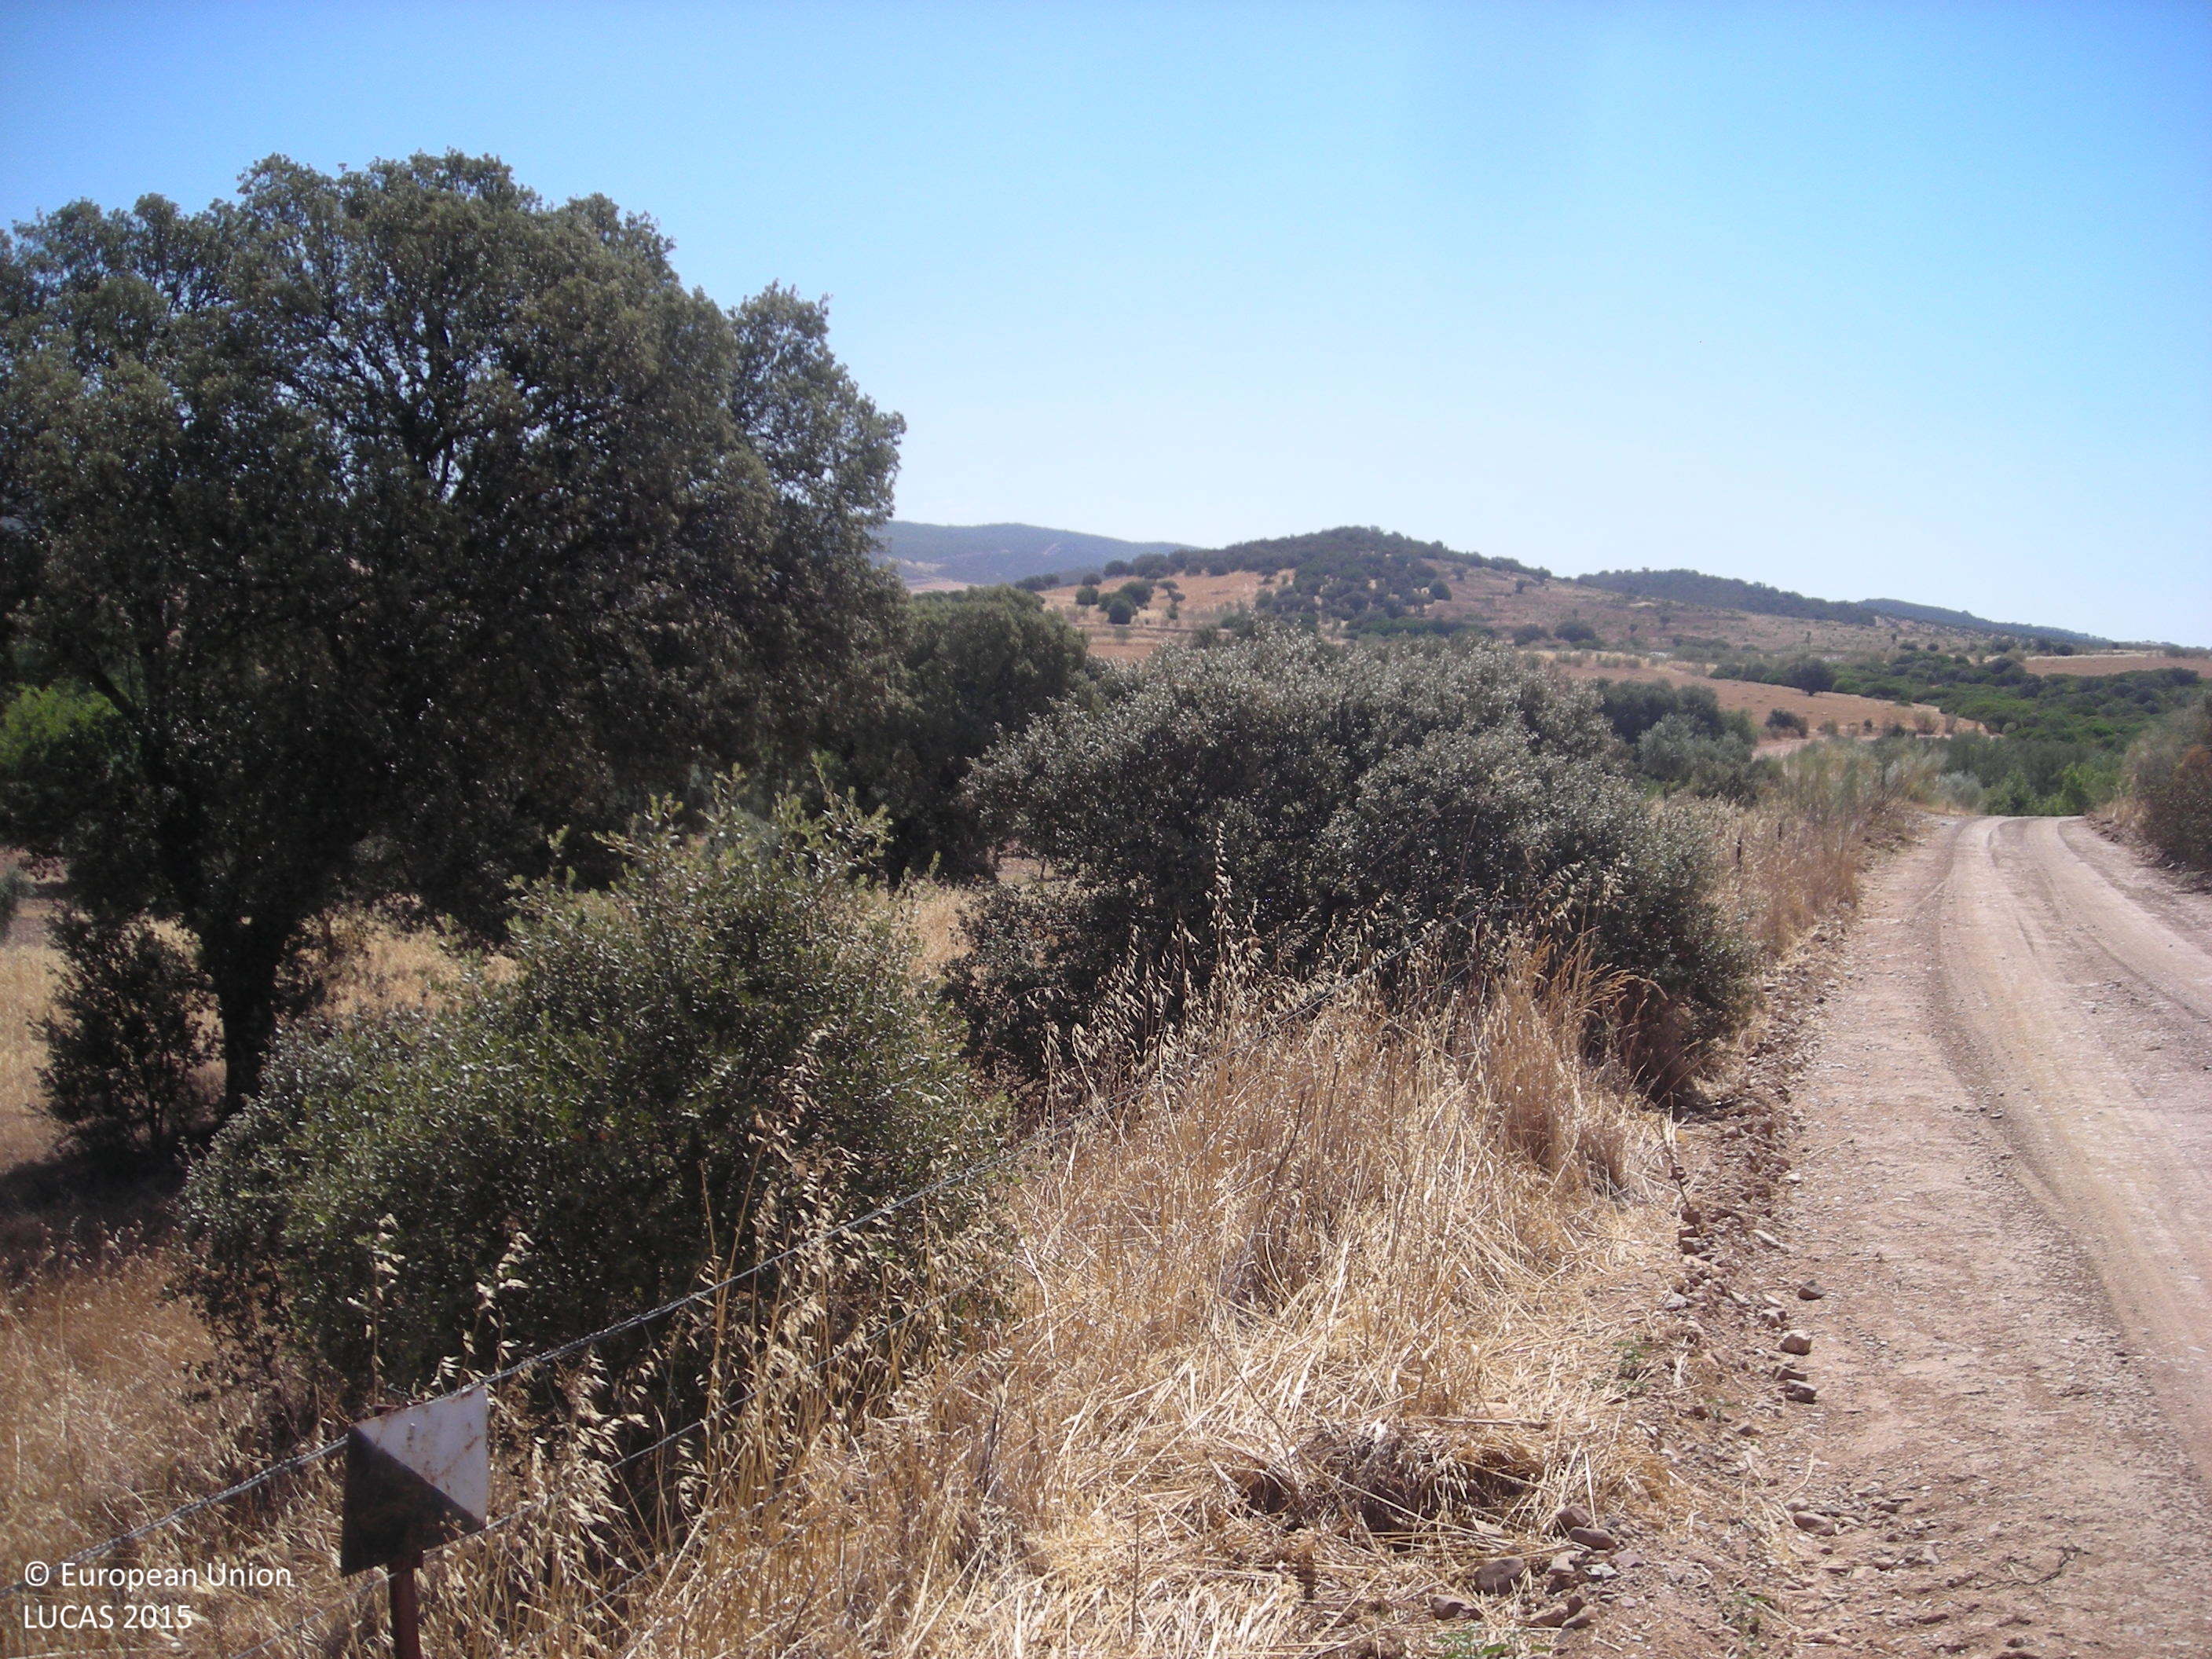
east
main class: Cropland
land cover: Temporary grasslands
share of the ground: > 75 %
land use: Agriculture (excluding fallow land and kitchen gardens)
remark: Harvested field
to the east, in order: Temporary grasslands
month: July
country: ES
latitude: 38.8094
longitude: -5.9284
